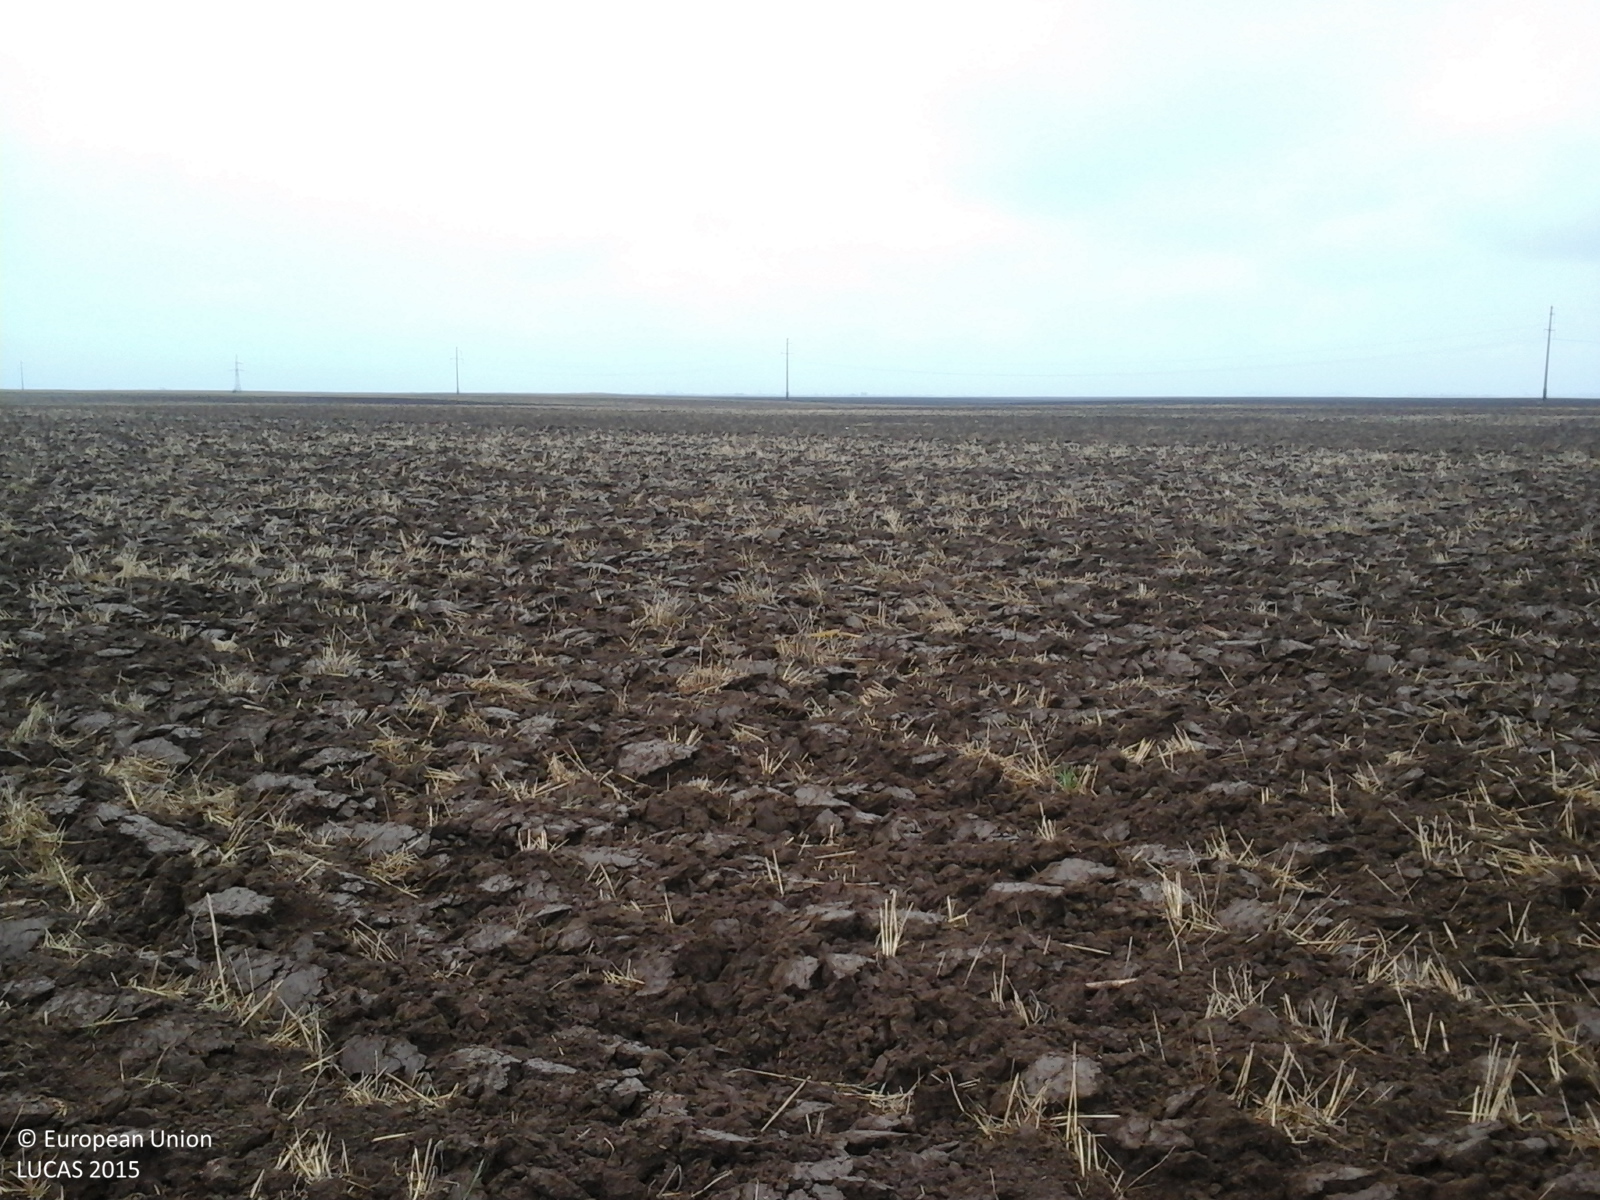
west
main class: Cropland
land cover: Common wheat
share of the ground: 10 - 25 %
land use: Agriculture (excluding fallow land and kitchen gardens)
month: September
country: RO
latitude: 46.9710
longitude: 21.7815
